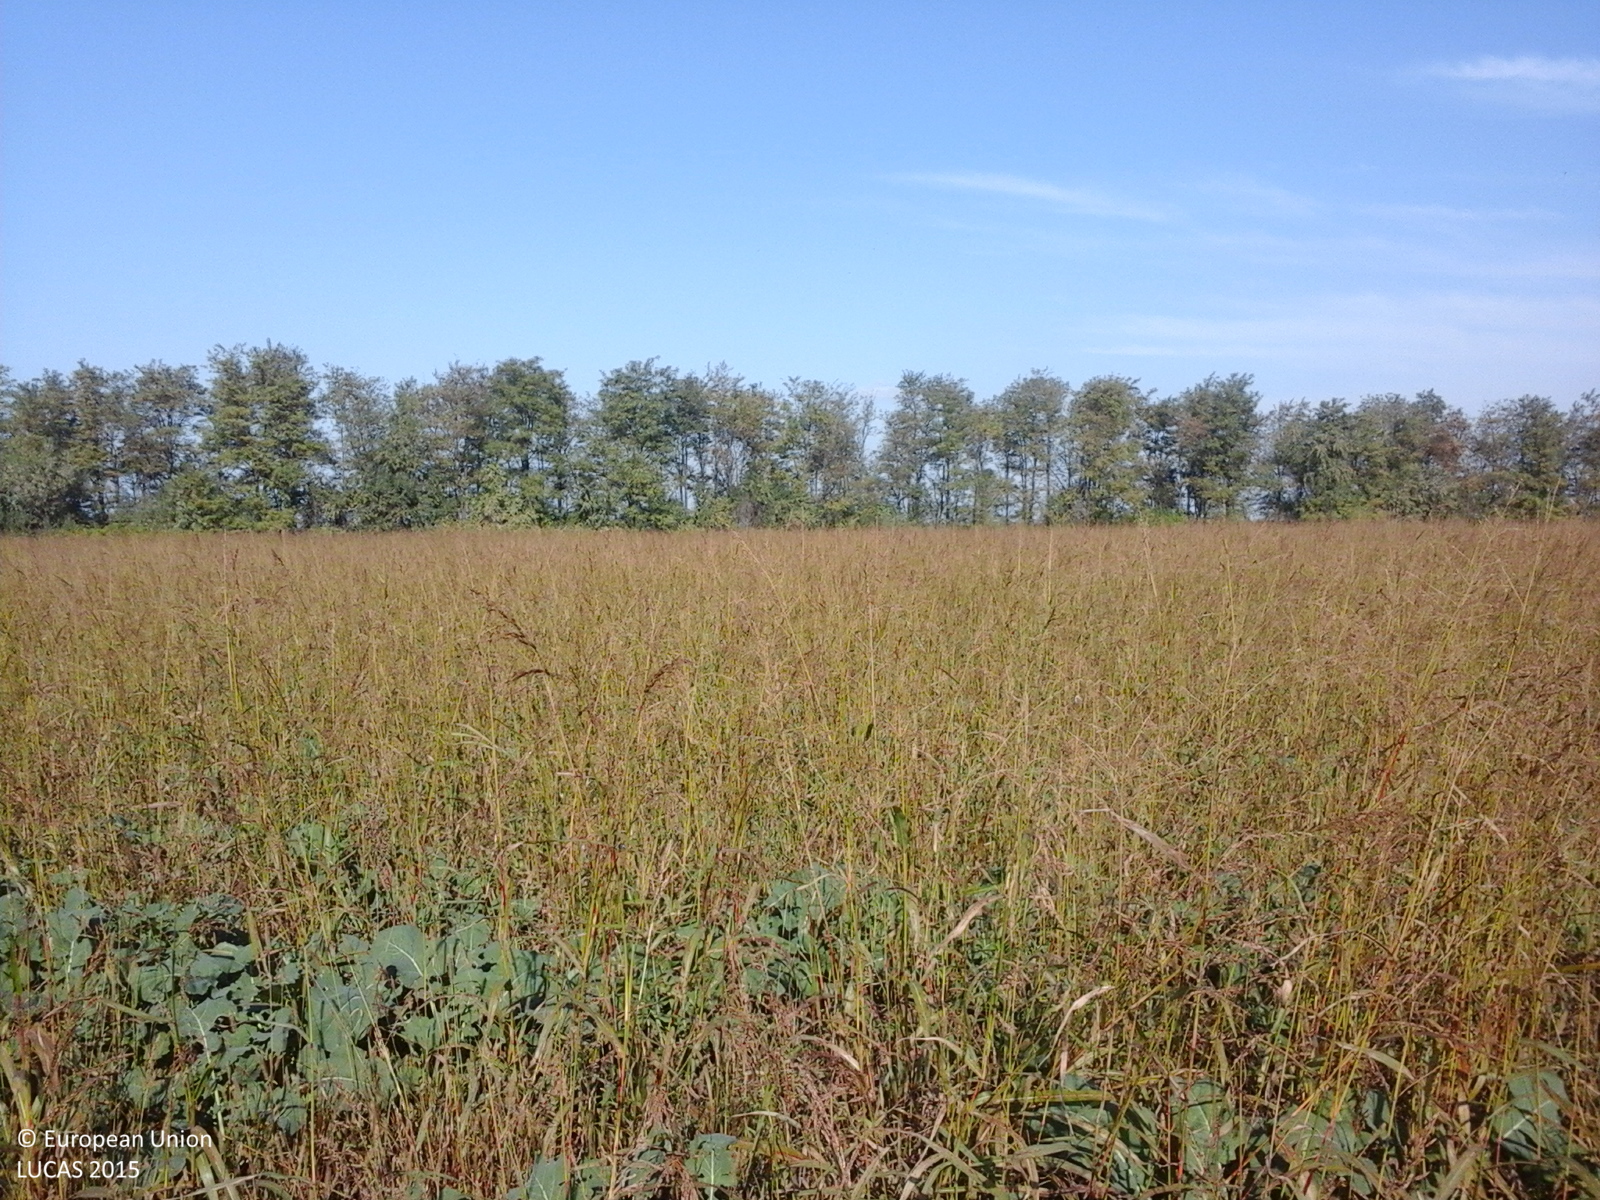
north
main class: Grassland
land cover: Spontaneously vegetated surfaces
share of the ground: > 75 %
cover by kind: herbaceous plants 100 %
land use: Fallow land
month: October
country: RO
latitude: 45.4494
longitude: 27.3723
